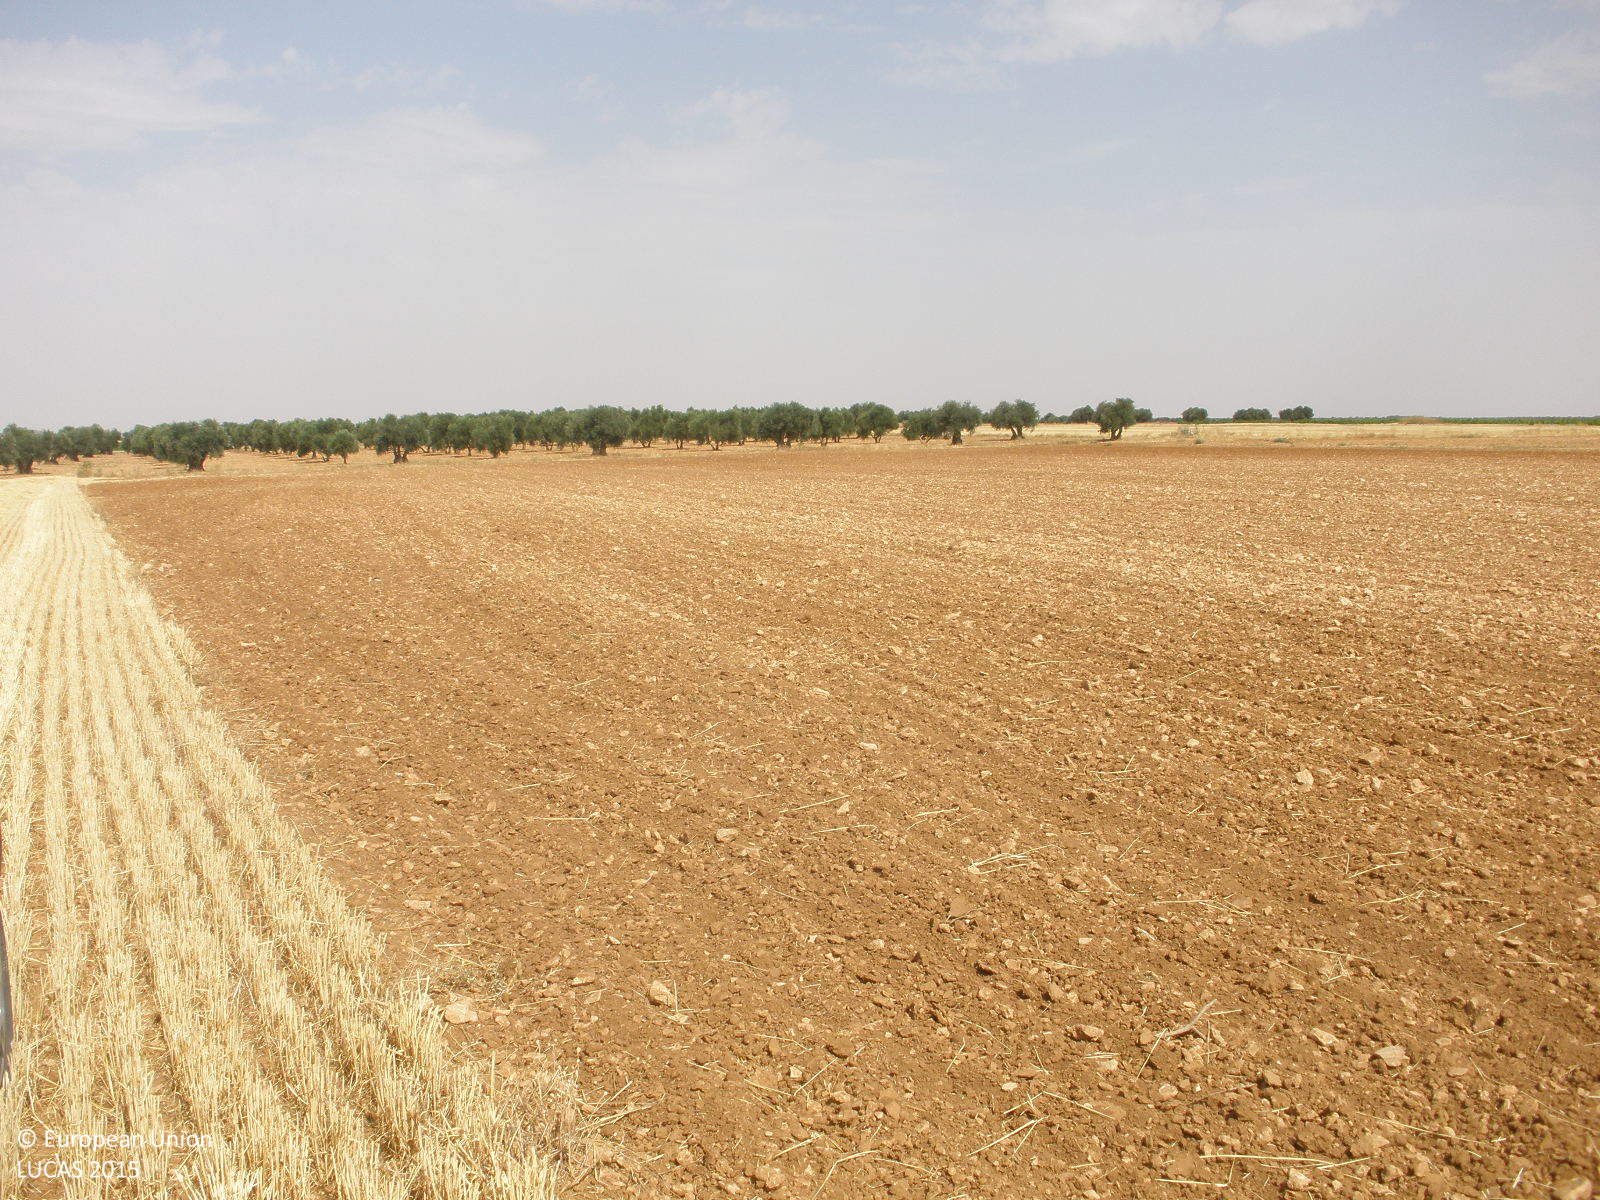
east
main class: Cropland
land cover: Barley
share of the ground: < 10 %
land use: Agriculture (excluding fallow land and kitchen gardens)
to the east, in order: Barley; Other bare soil; Grass margins; Tracks; Olive groves
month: July
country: ES
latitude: 39.9019
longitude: -3.4671
